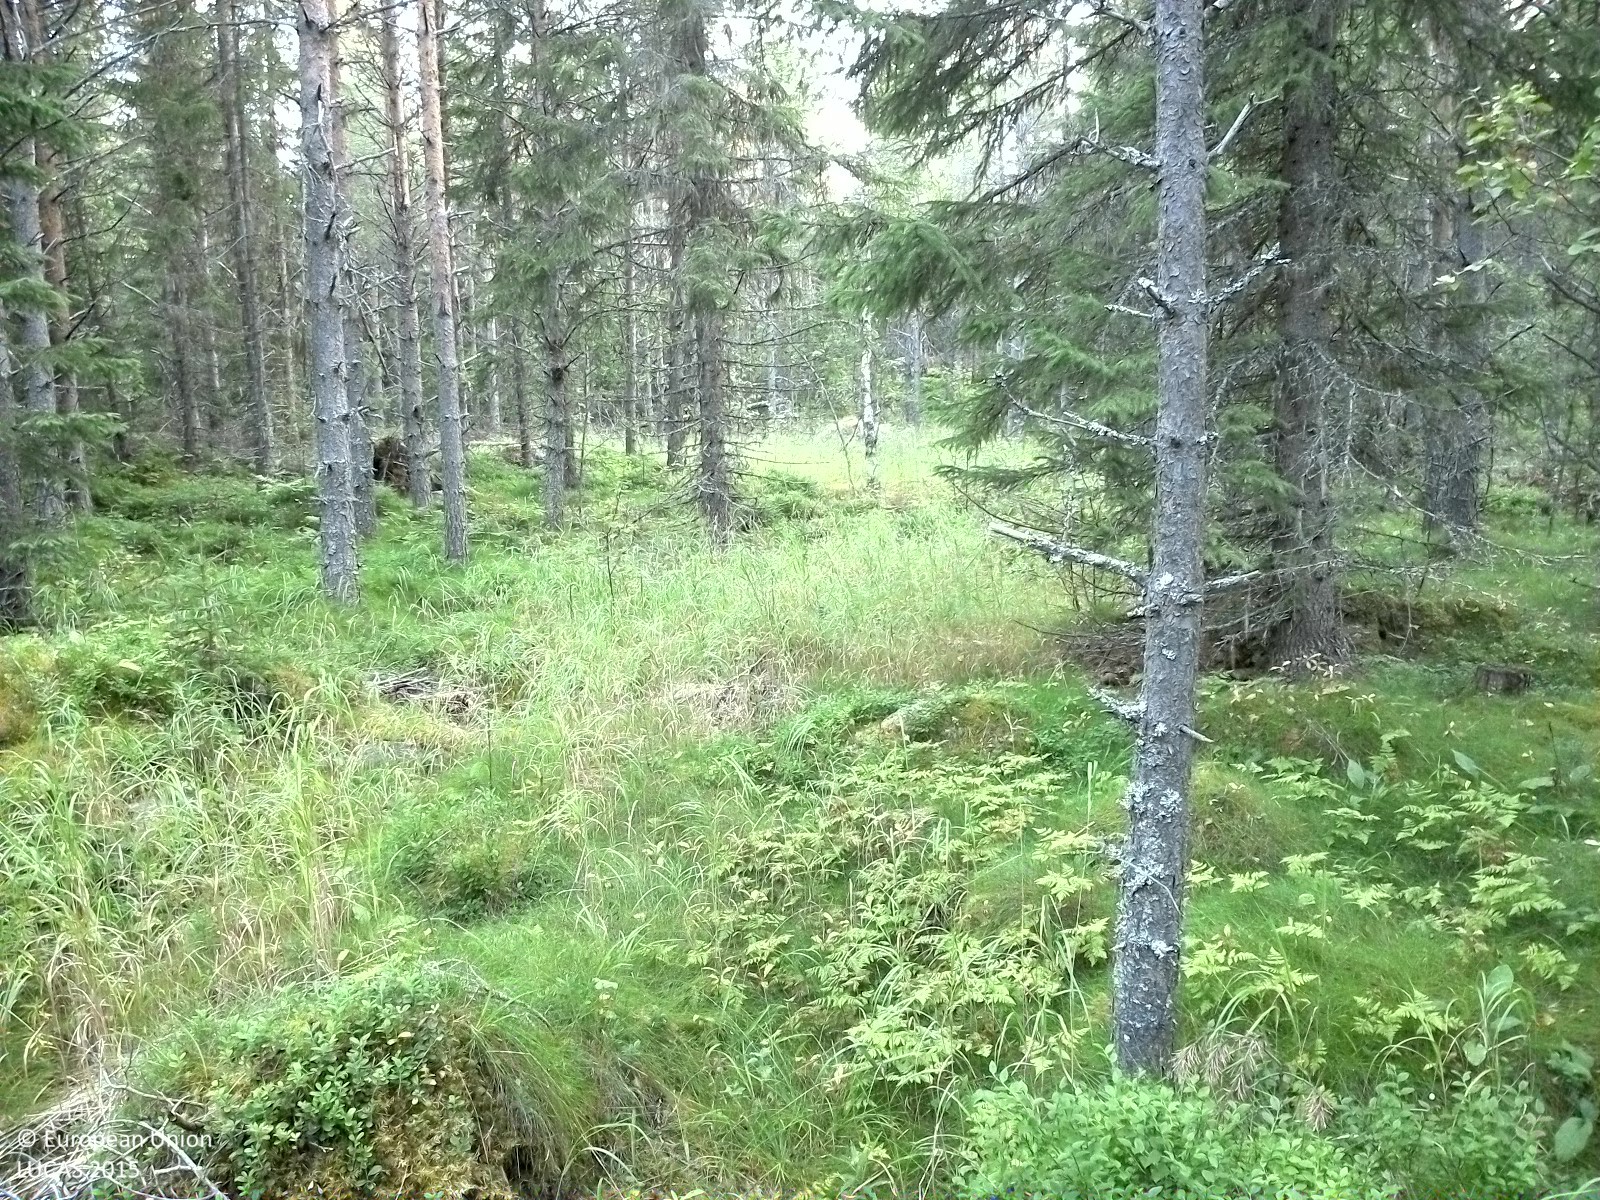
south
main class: Woodland
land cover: Other coniferous woodland
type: boreal forest
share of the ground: 25 - 50 %
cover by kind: coniferous forest trees 35 %, lichens and mosses 25 %, shrubs 20 %, herbaceous plants 20 %
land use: Forestry
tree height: > 5 m
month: August
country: SE
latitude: 62.3245
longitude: 16.1365
